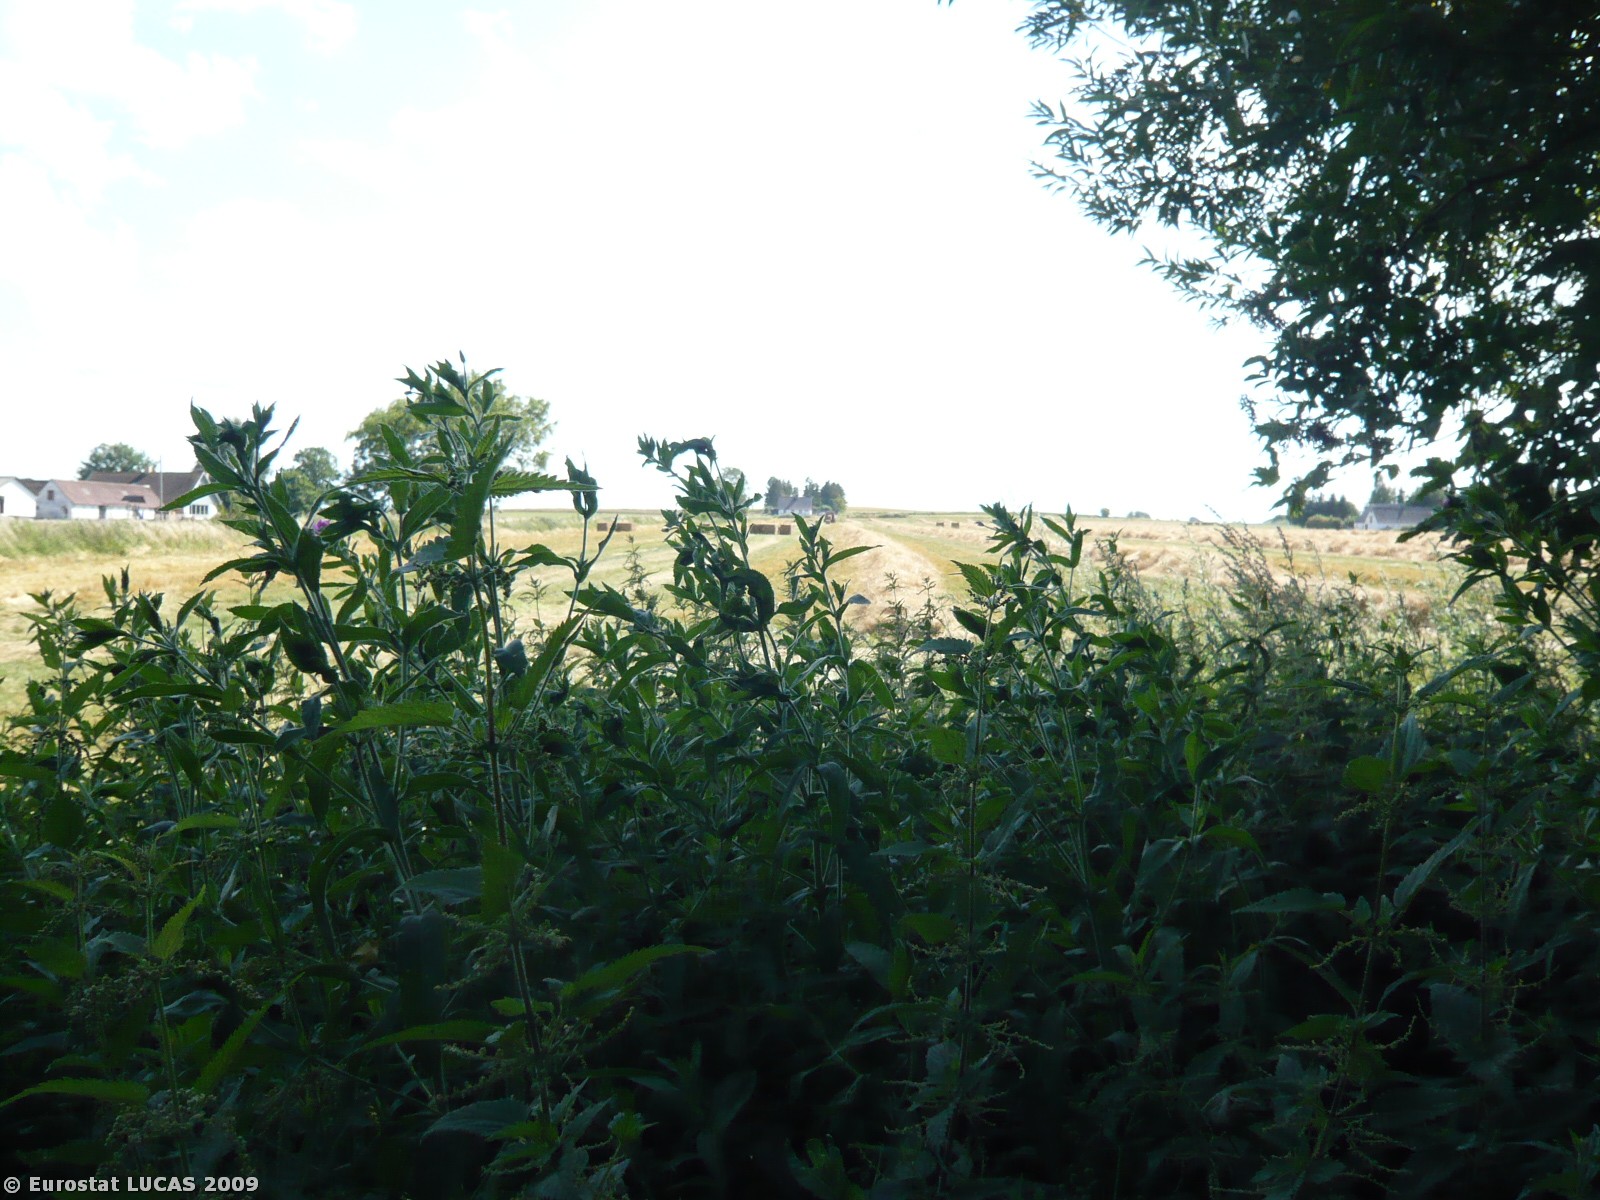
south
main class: Grassland
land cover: Grassland without tree/shrub cover
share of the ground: > 75 %
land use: Agriculture (excluding fallow land and kitchen gardens)
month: July
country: DK
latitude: 55.7809
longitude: 11.7044
